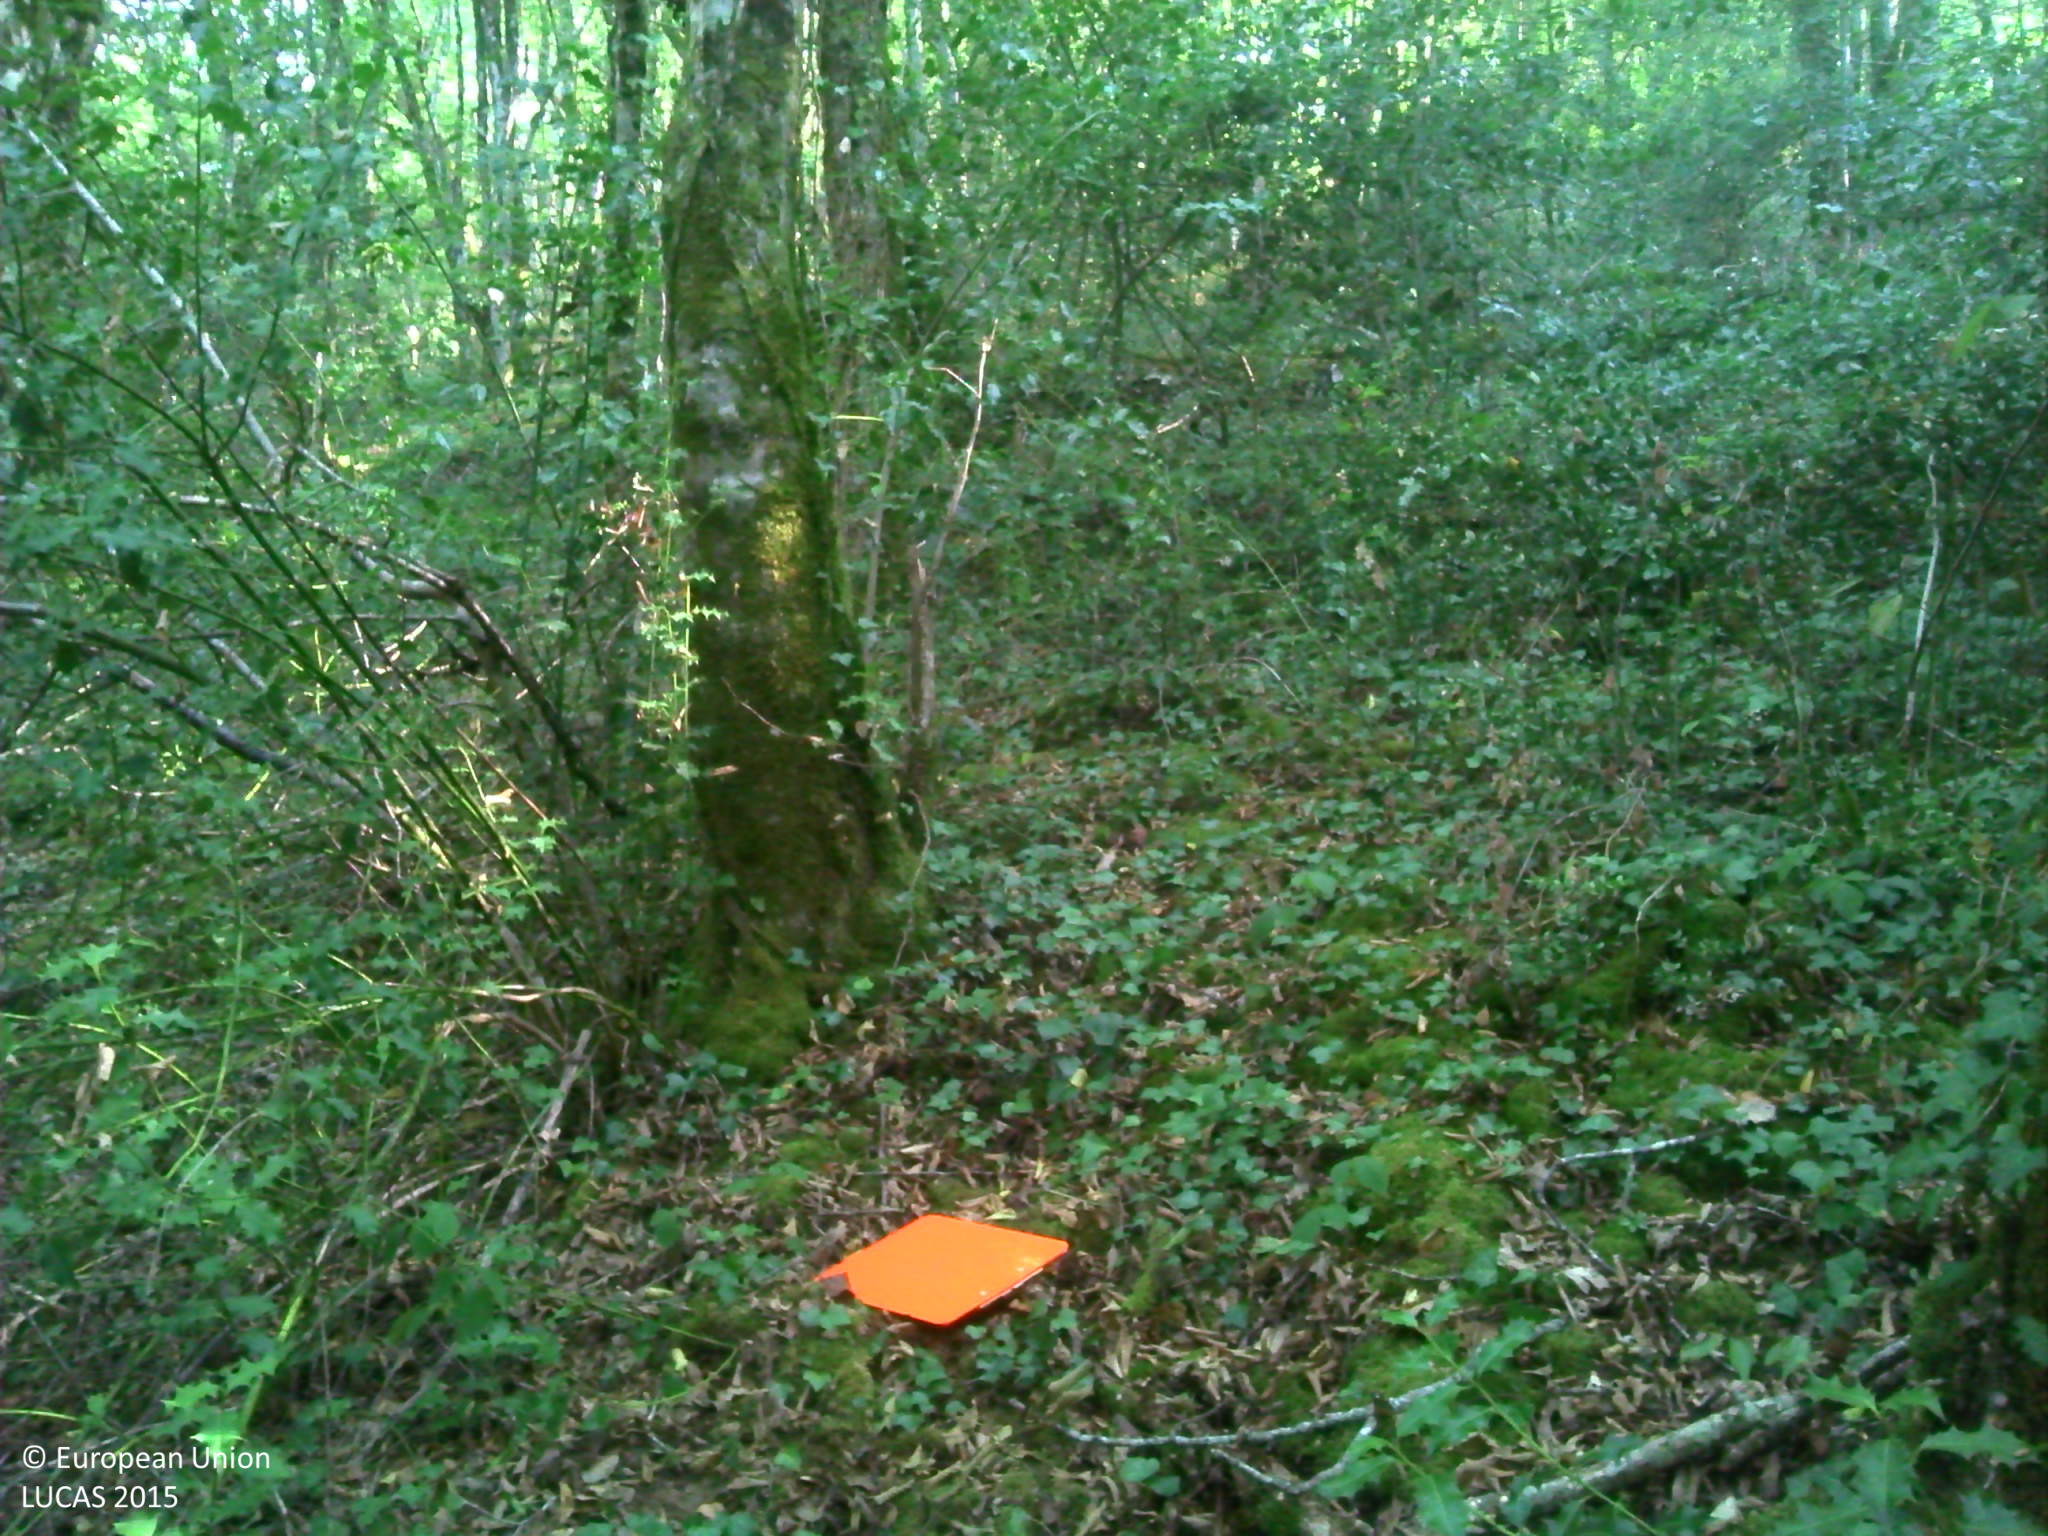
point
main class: Woodland
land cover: Broadleaved woodland
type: mesophytic deciduous forest
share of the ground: 50 - 75 %
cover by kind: broadleaved forest trees 80 %, herbaceous plants 20 %
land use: Forestry
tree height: > 5 m
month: August
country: FR
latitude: 45.3690
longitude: 1.8372
